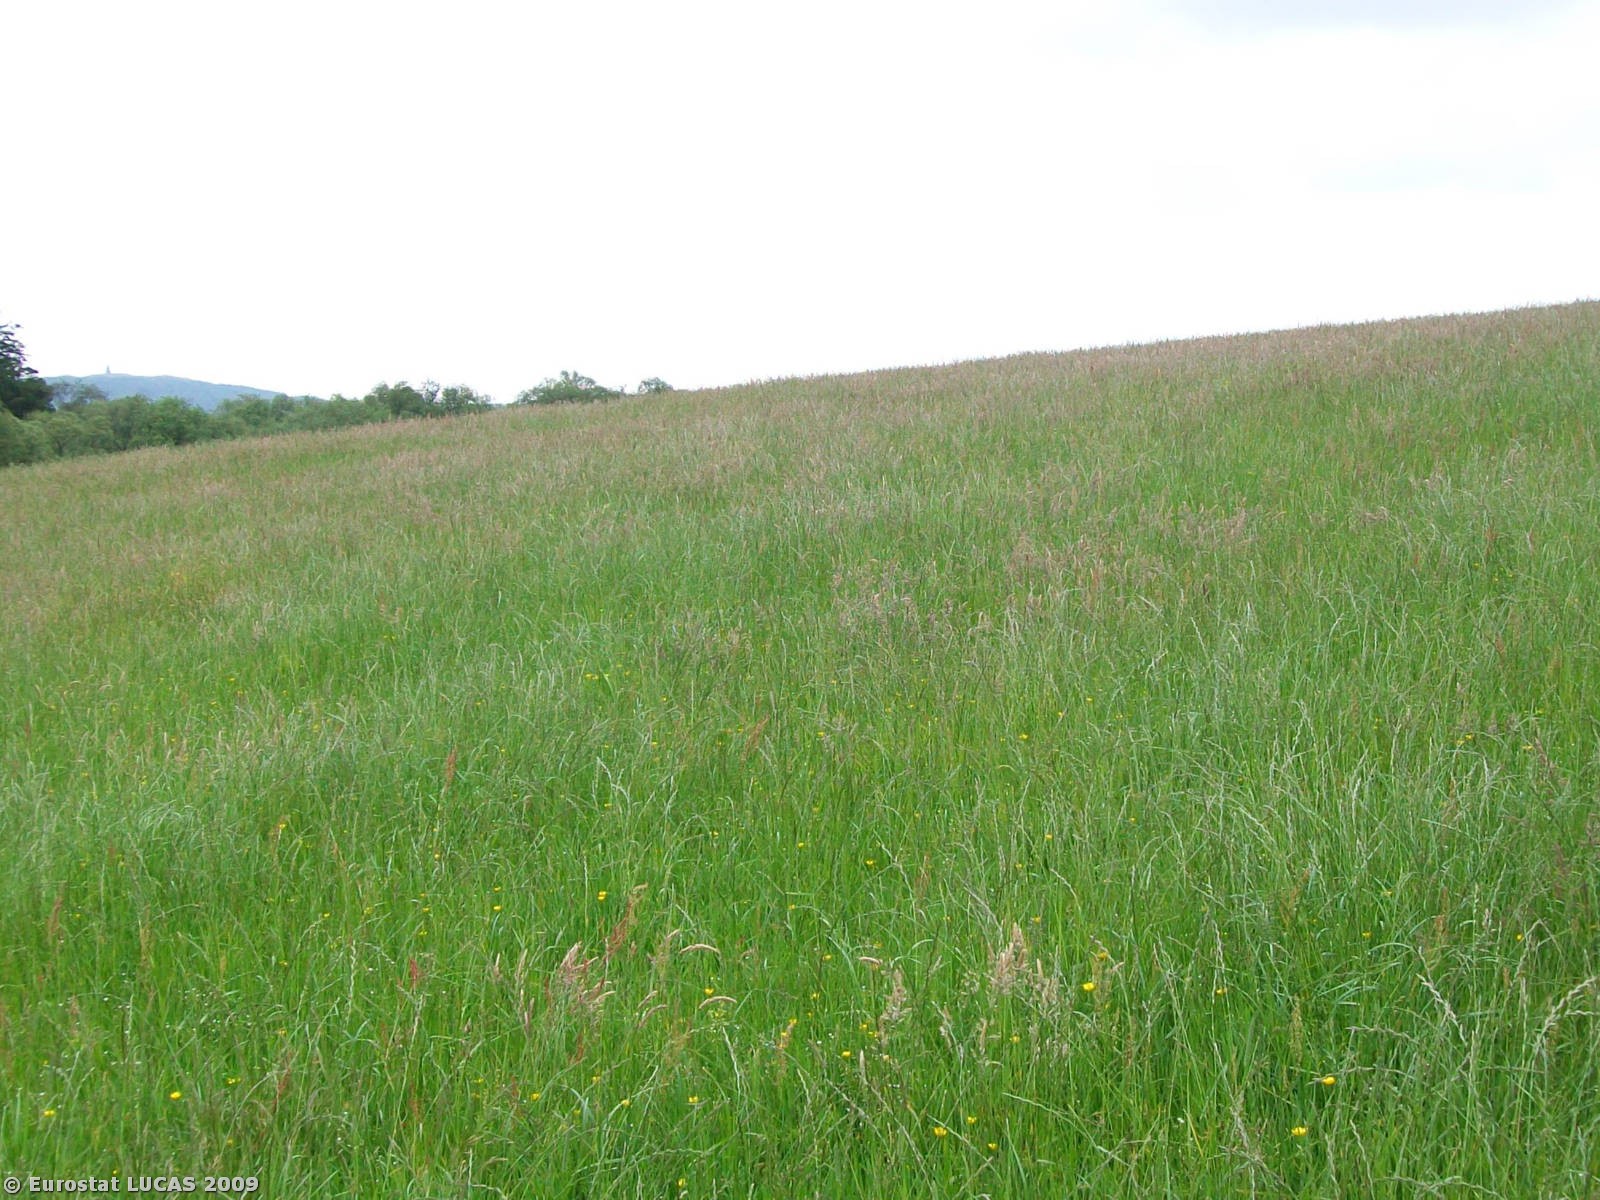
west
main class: Grassland
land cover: Grassland without tree/shrub cover
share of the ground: > 75 %
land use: Agriculture (excluding fallow land and kitchen gardens)
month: June
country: GB
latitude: 54.9505
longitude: -4.0666
